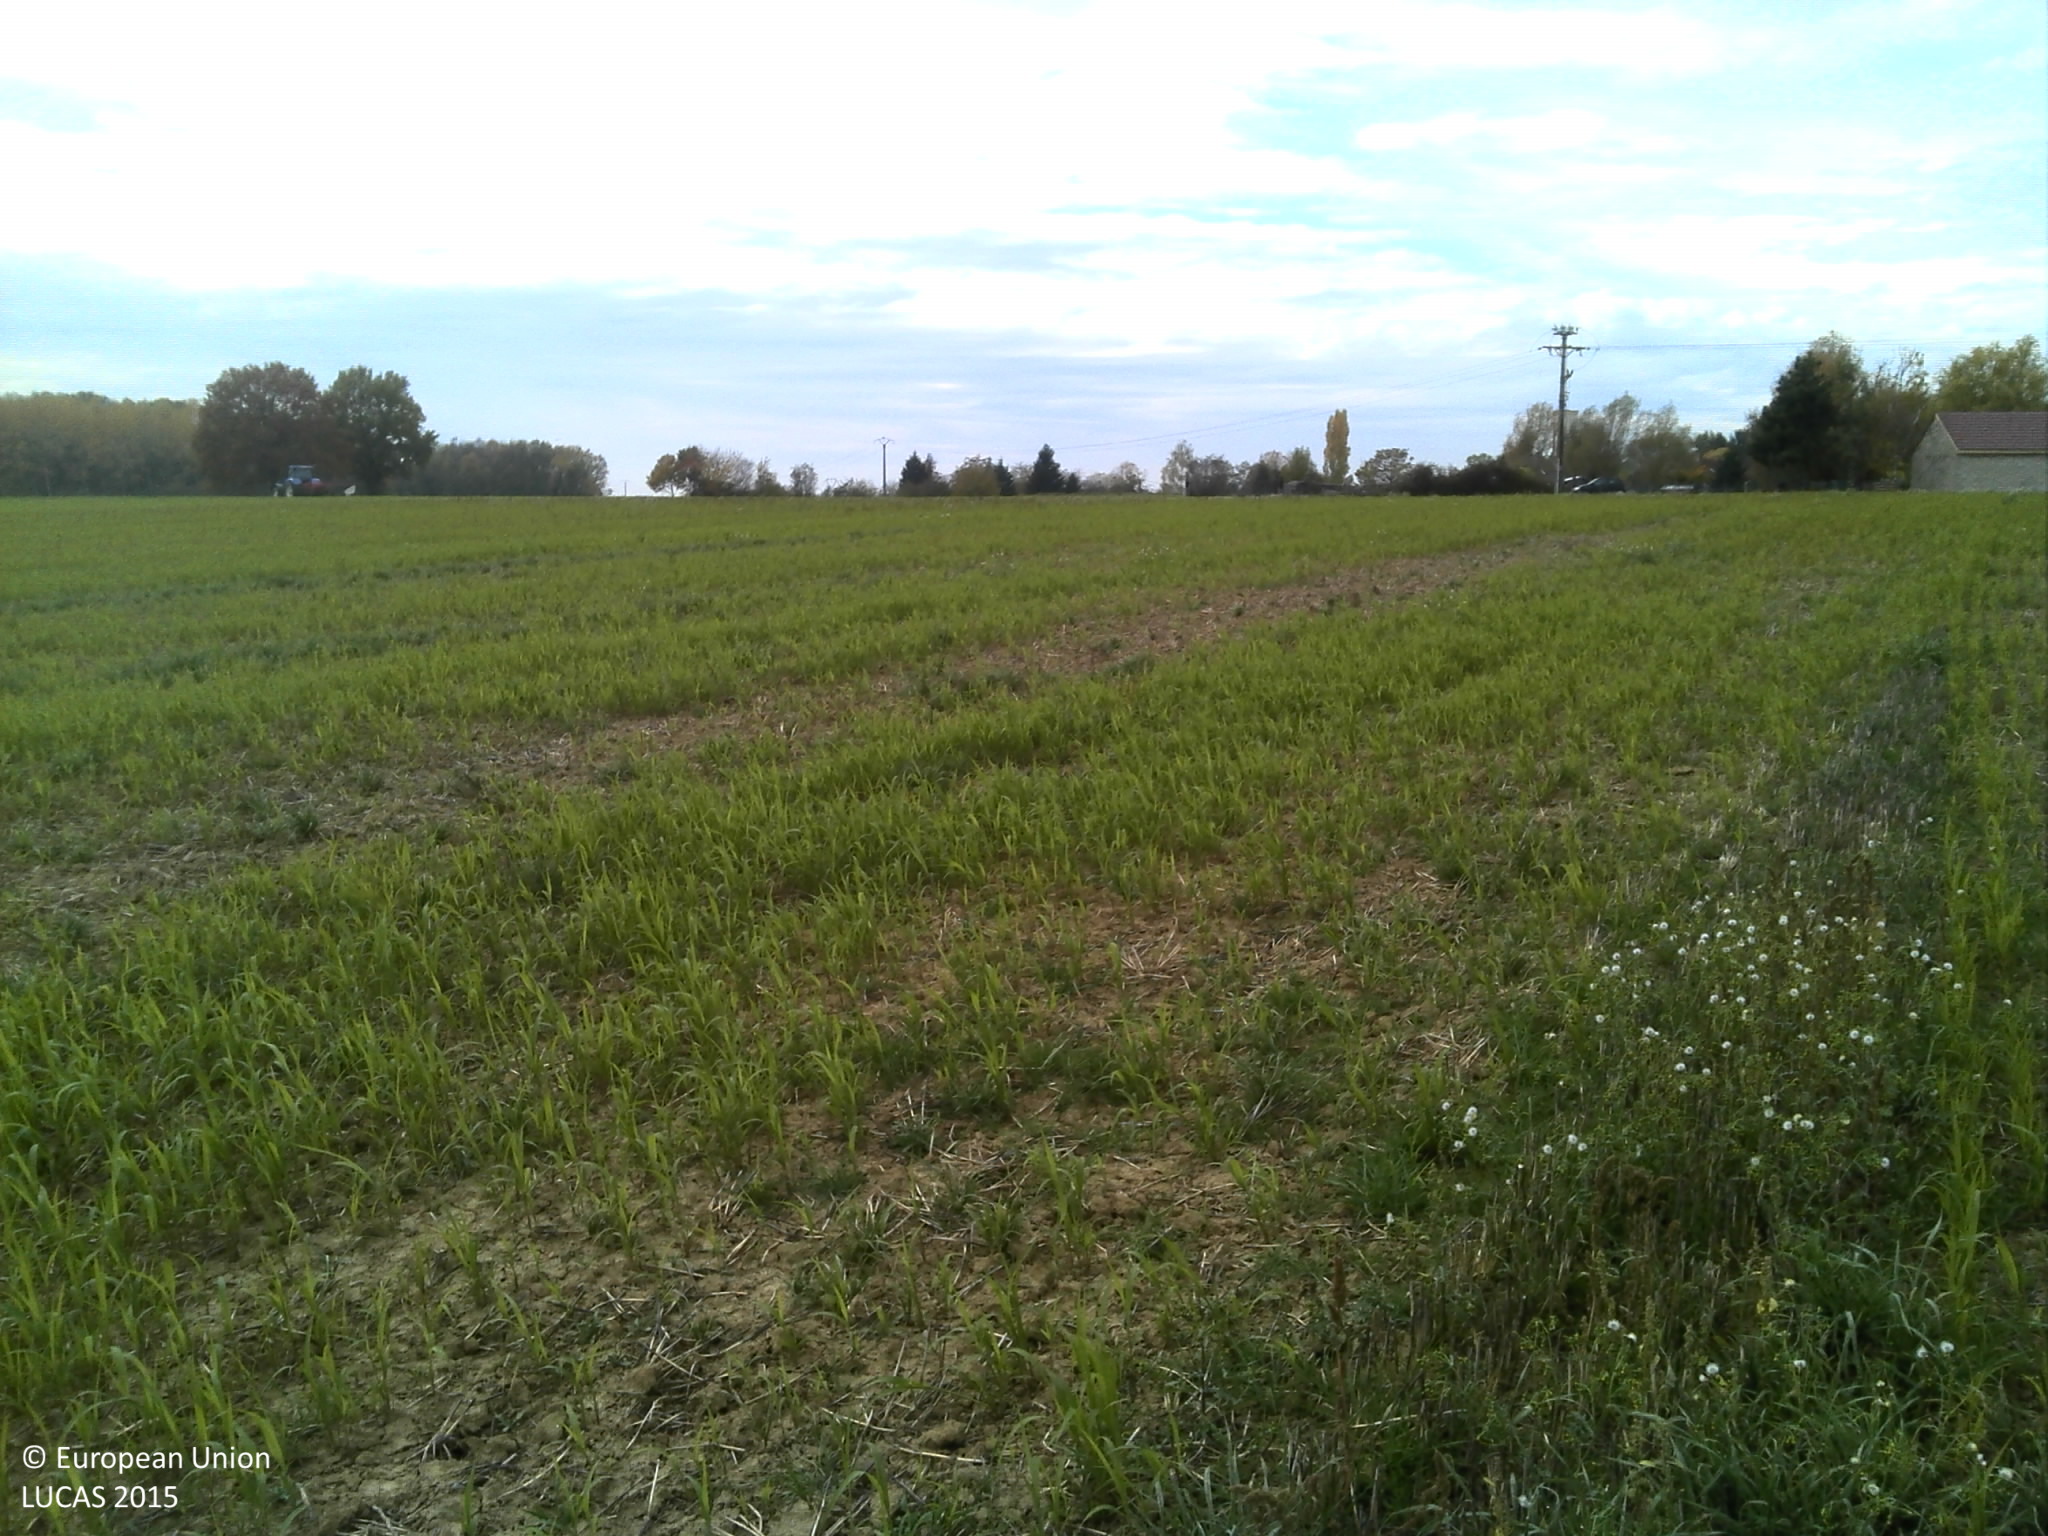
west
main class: Cropland
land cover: Common wheat
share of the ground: 10 - 25 %
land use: Agriculture (excluding fallow land and kitchen gardens)
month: October
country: FR
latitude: 47.1170
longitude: 5.3752
